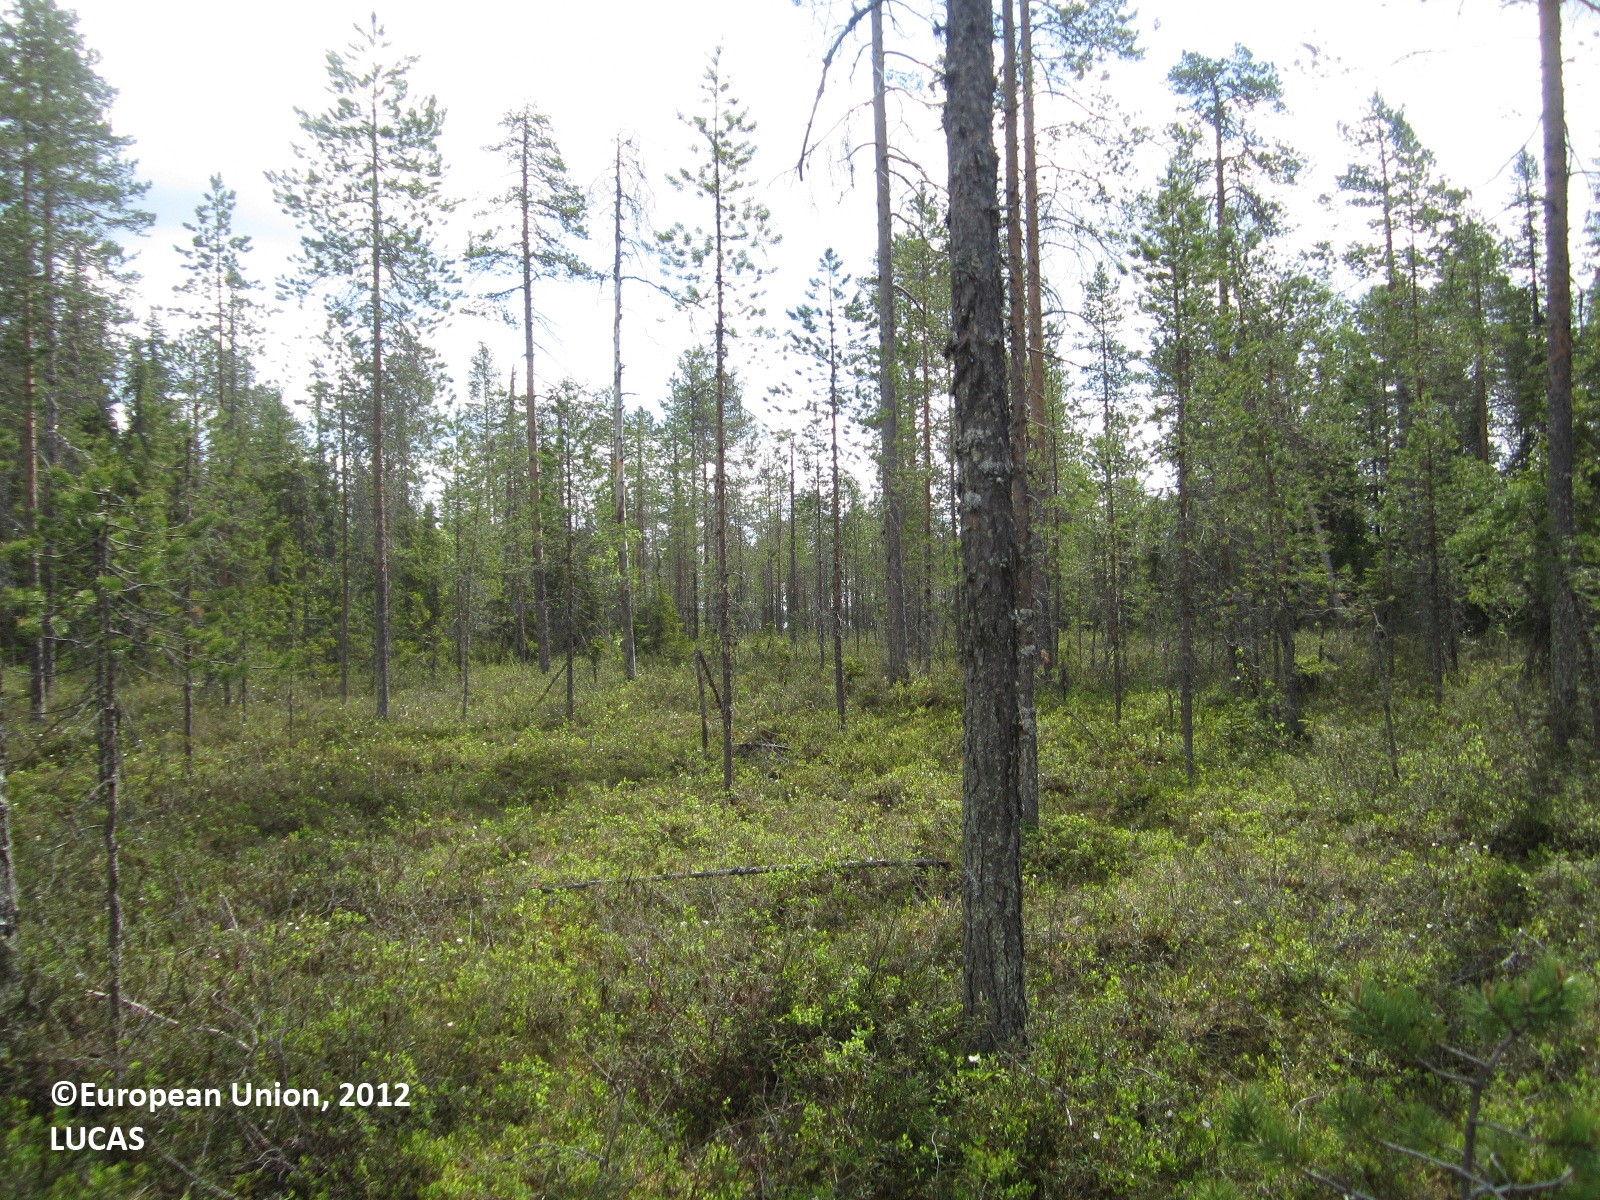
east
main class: Woodland
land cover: Pine dominated coniferous woodland
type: boreal forest
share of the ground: 25 - 50 %
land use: Forestry
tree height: > 5 m
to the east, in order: Pine dominated coniferous woodland; Inland water bodies
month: June
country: FI
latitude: 64.9410
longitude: 29.2629
